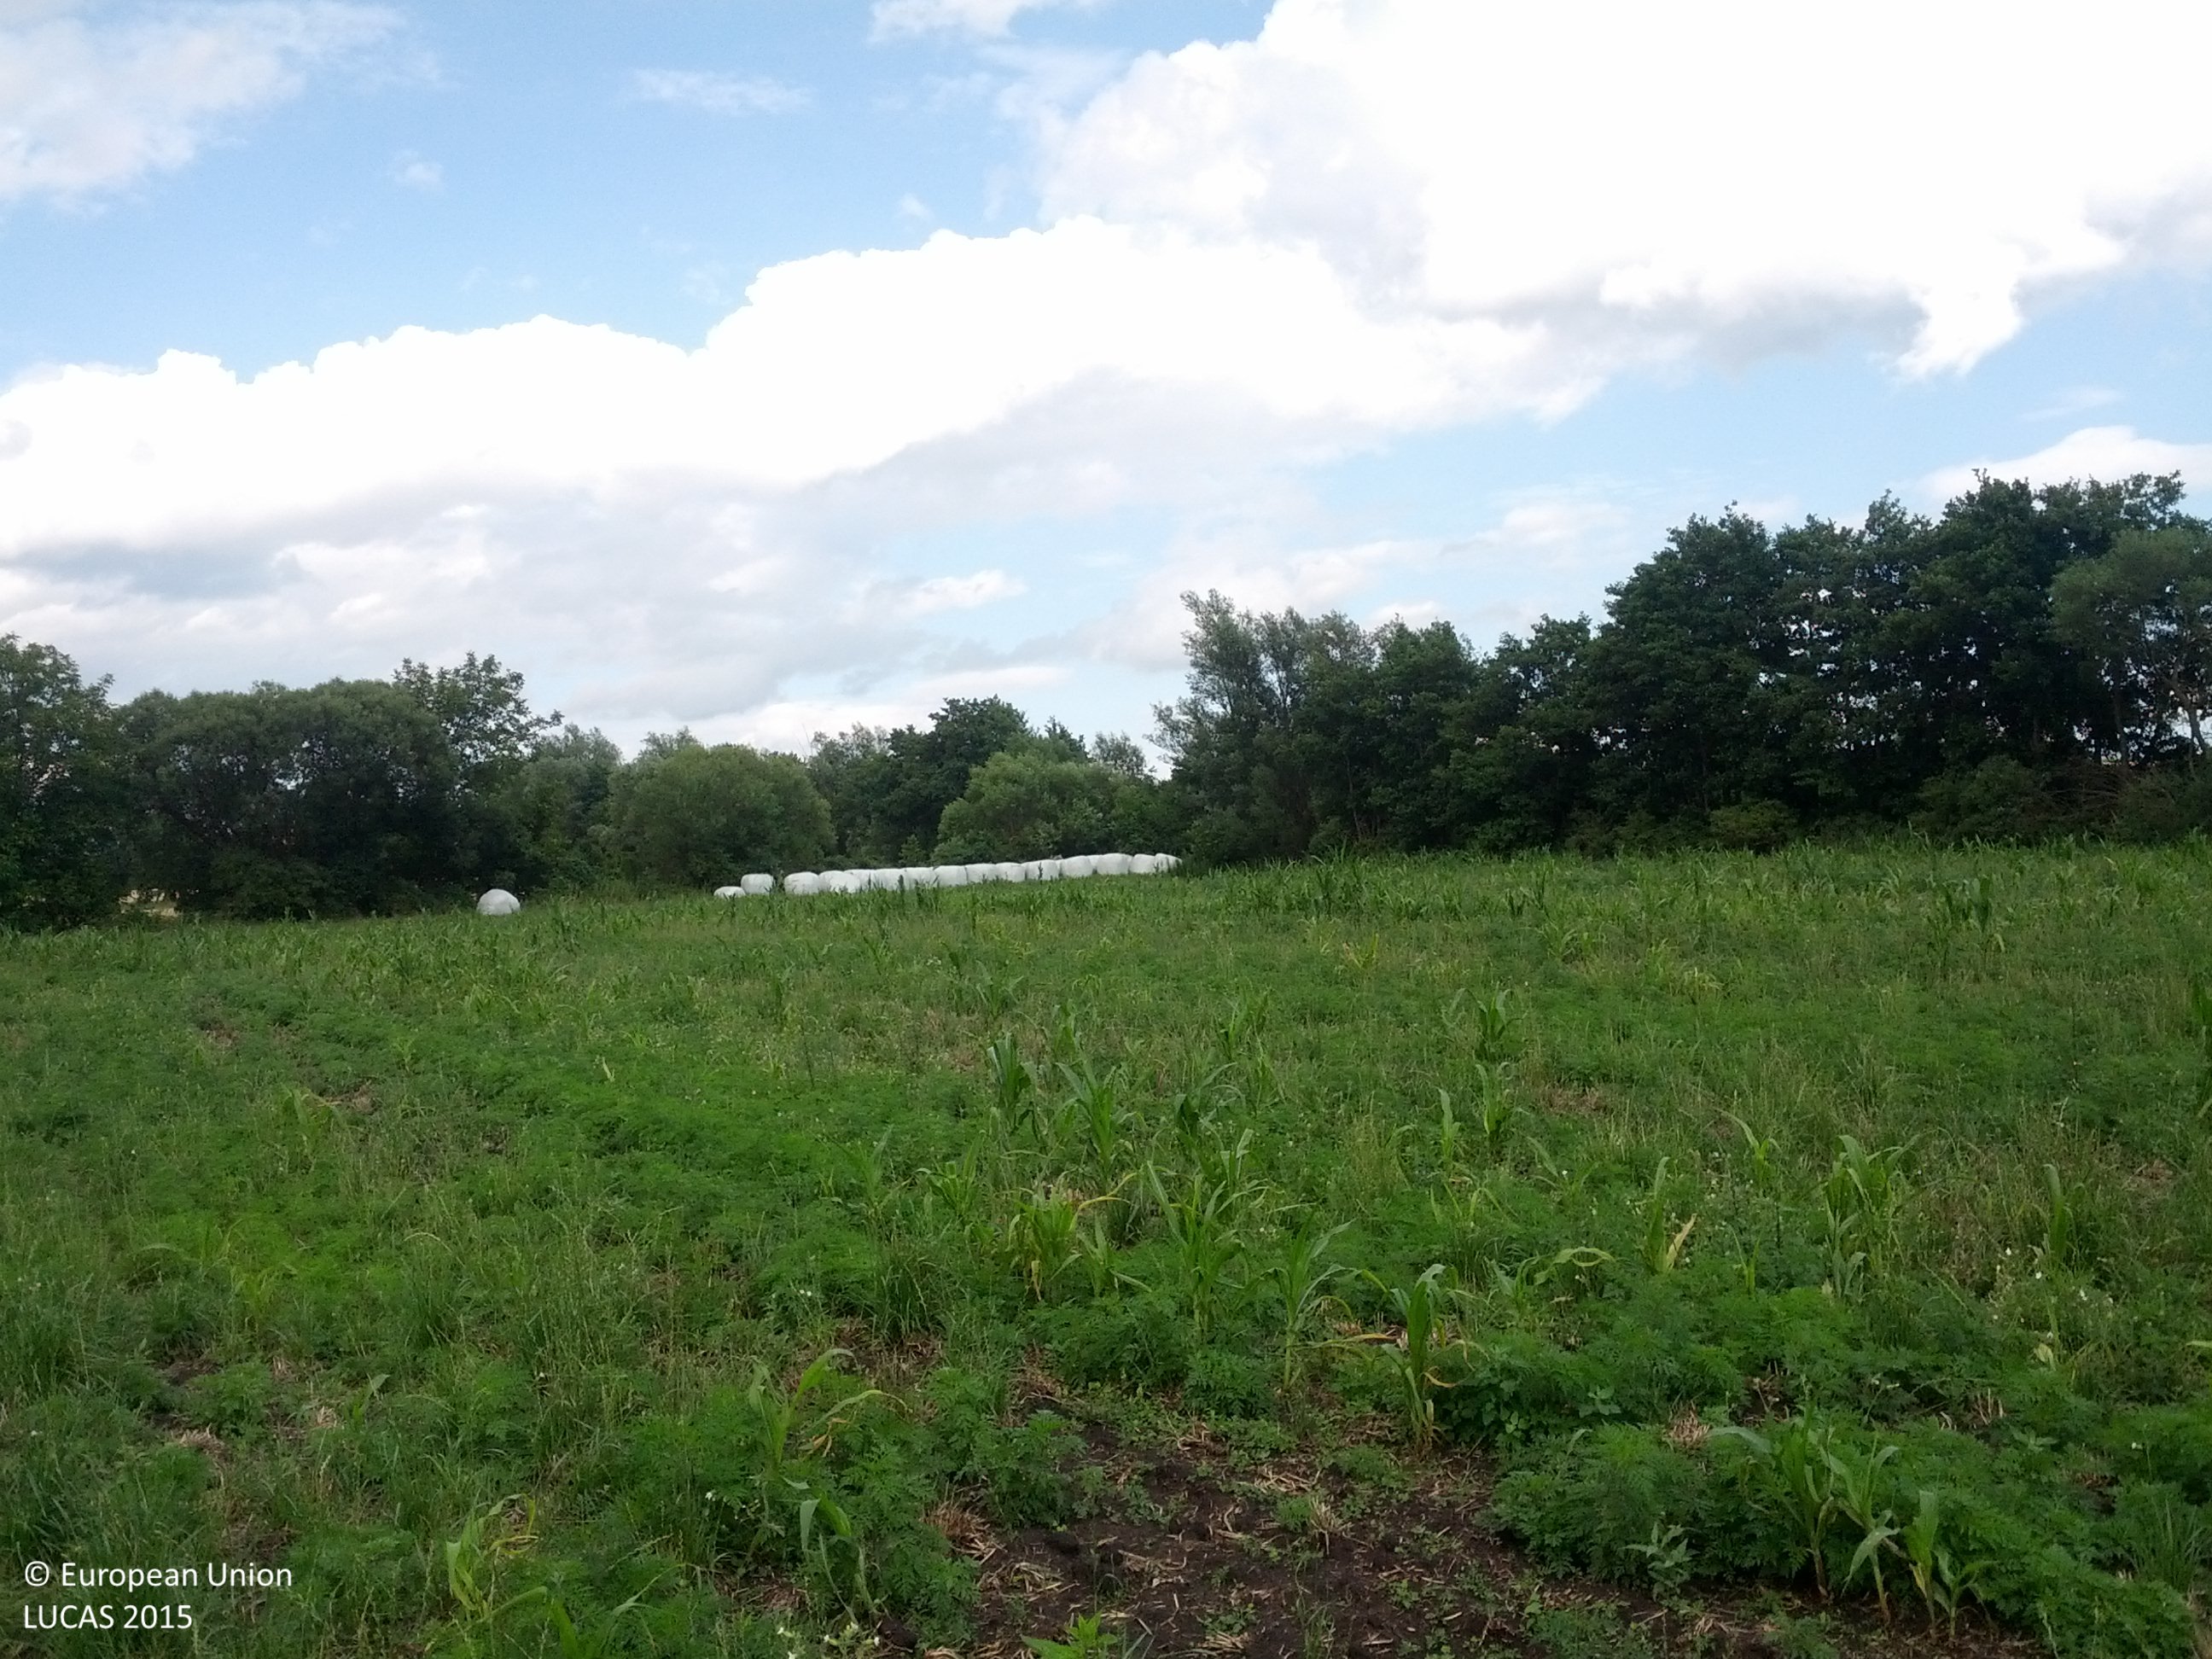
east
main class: Cropland
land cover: Temporary grasslands
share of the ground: > 75 %
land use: Agriculture (excluding fallow land and kitchen gardens)
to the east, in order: Temporary grasslands; Abandoned hedges; Grass margins; Common wheat; Grass margins; Rivers and streams; Abandoned hedges; Grassland without tree/shrub cover; Tracks; Grass margins; Ditches and canals; Grass margins; Broadleaved woodland
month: July
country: AT
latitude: 47.3112
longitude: 16.4717
